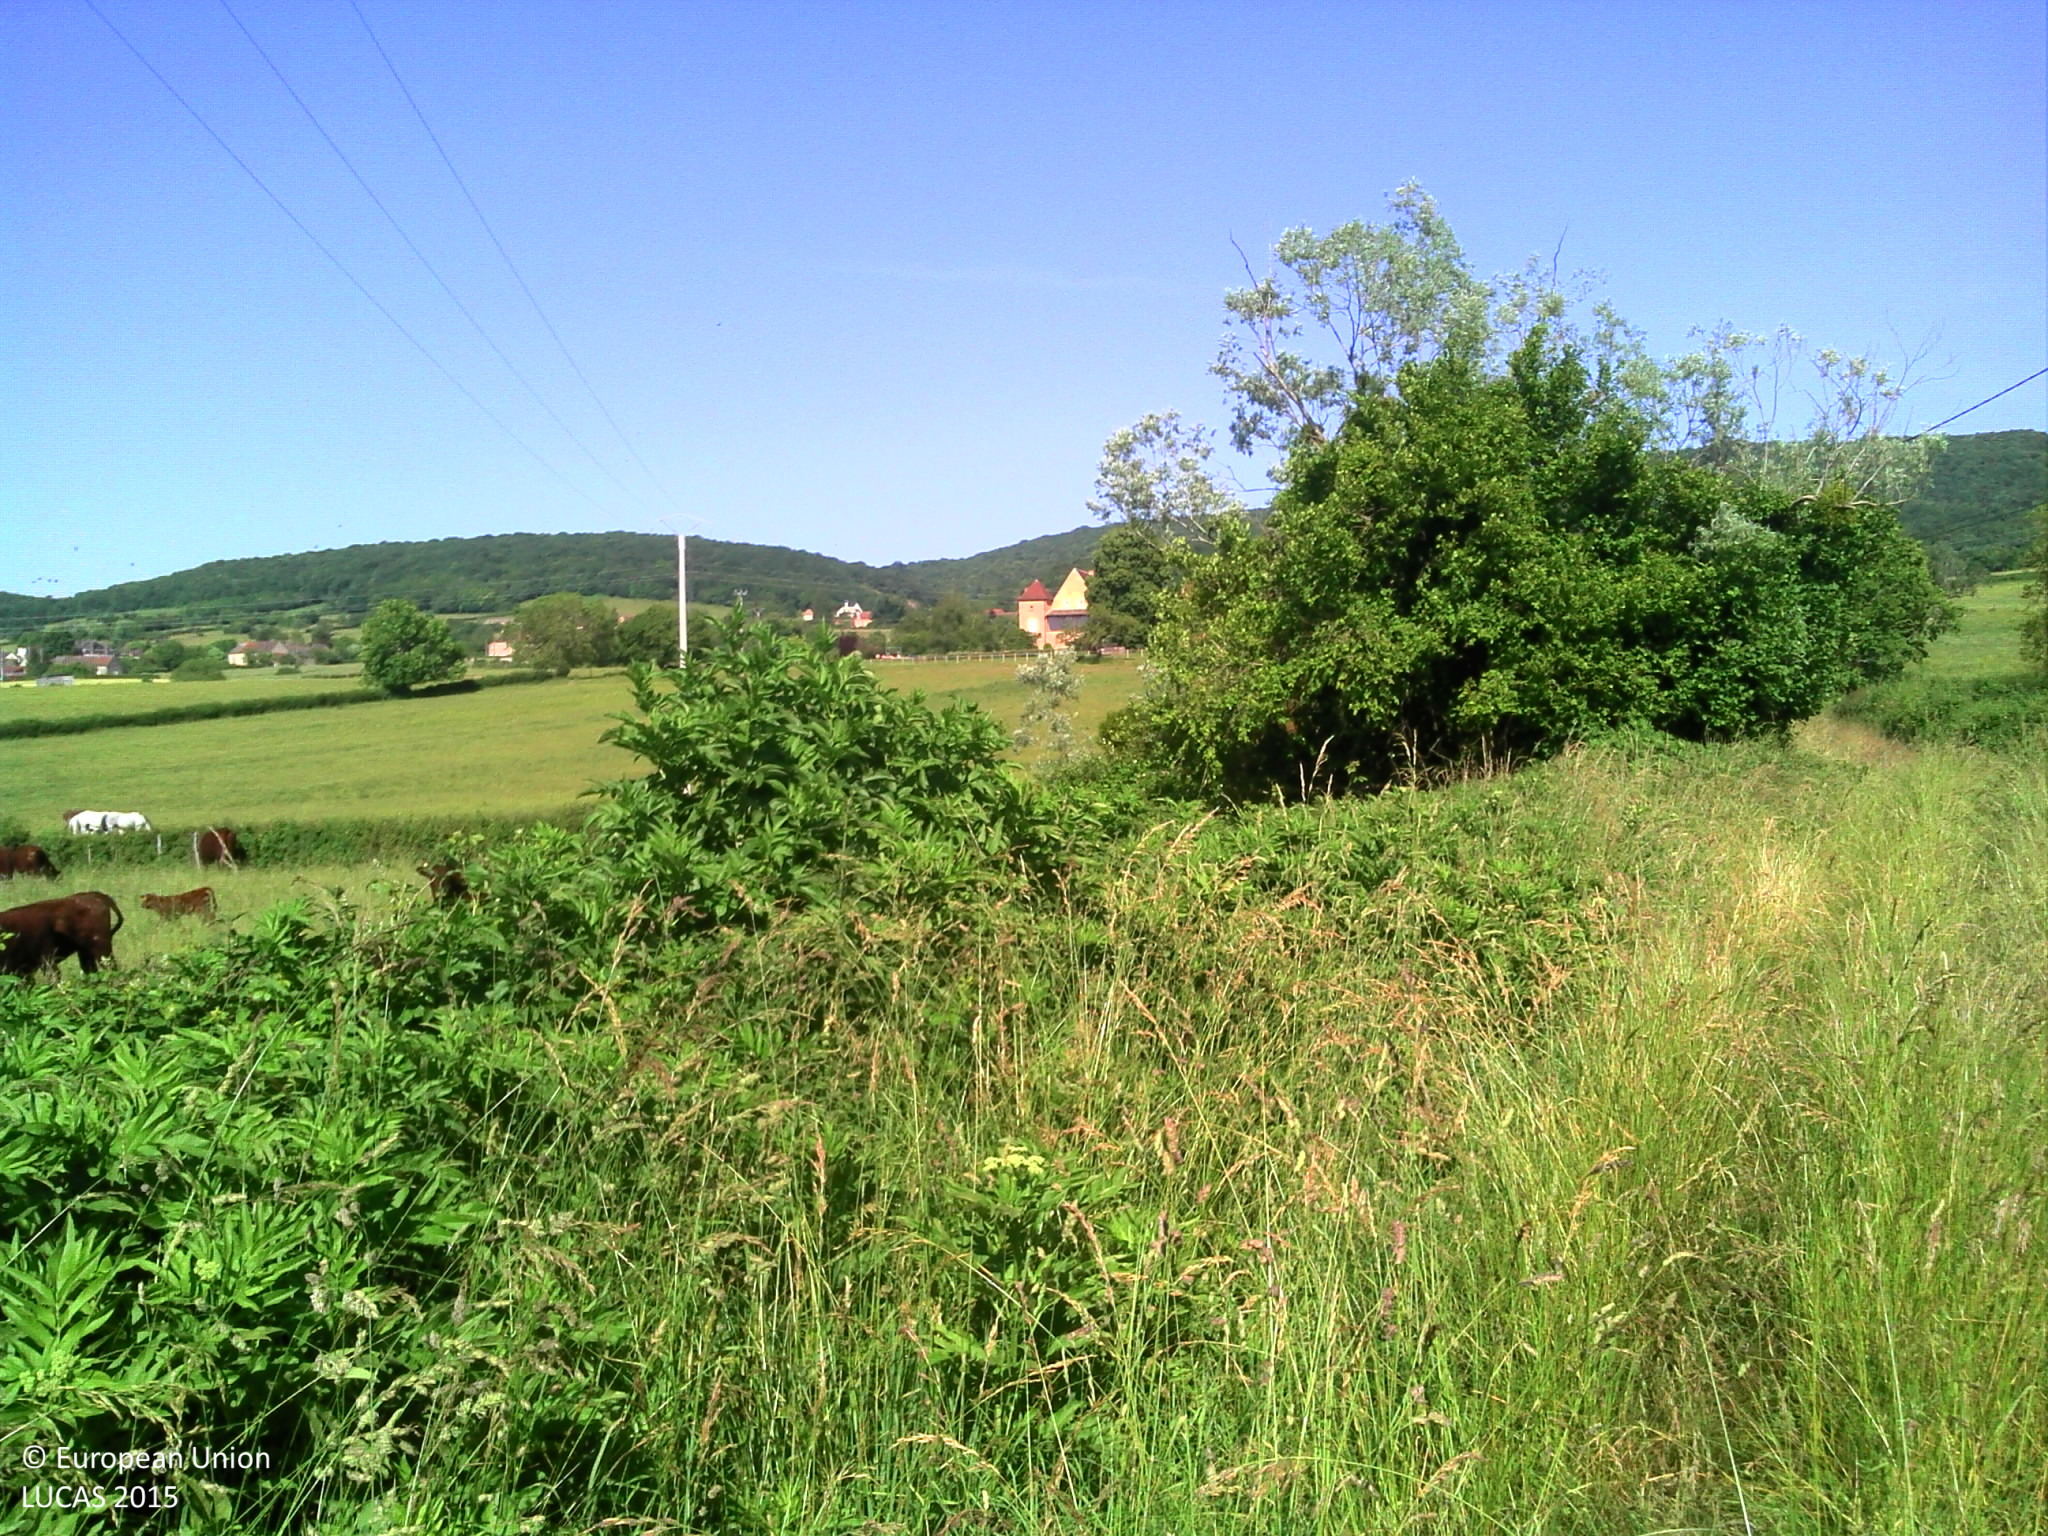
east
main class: Grassland
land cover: Grassland without tree/shrub cover
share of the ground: > 75 %
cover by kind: herbaceous plants 85 %, unconsolidated bare surface 15 %
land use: Agriculture (excluding fallow land and kitchen gardens)
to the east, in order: Grassland without tree/shrub cover; Electric lines; Grassland without tree/shrub cover; Managed hedges; Fences; Tracks; Abandoned hedges; Grassland without tree/shrub cover; Electric lines; Grassland without tree/shrub cover; Single bushes/trees; Grassland without tree/shrub cover; Broadleaved woodland; Tracks; Managed hedges; Grassland without tree/shrub cover
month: June
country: FR
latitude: 46.5854
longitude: 4.7944
